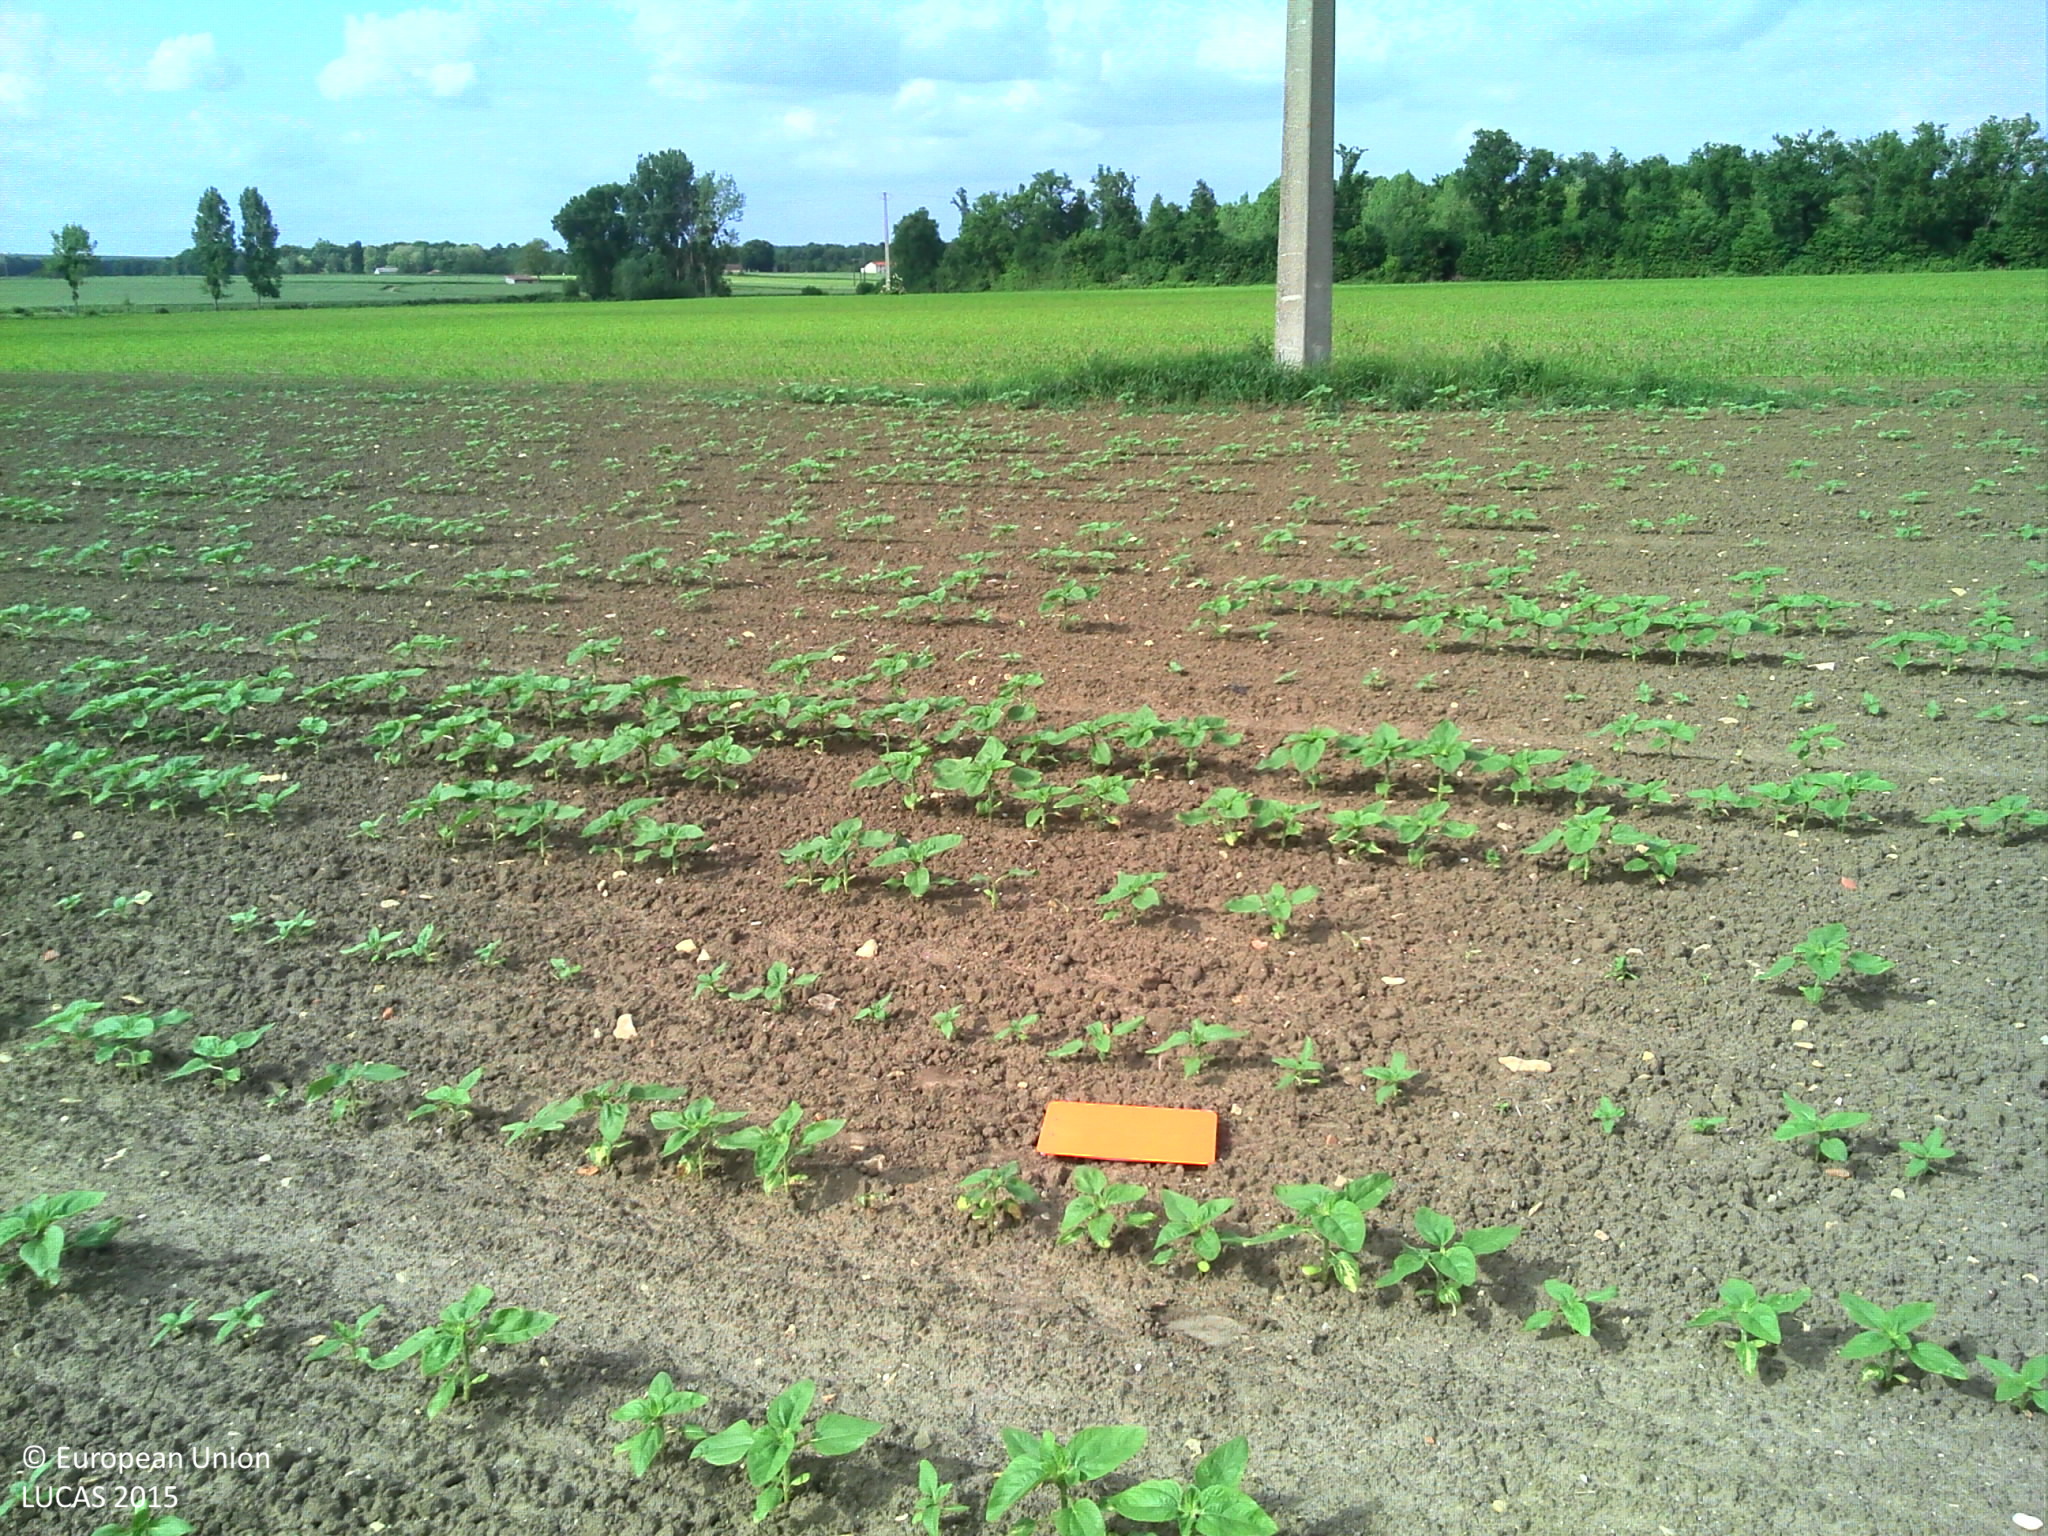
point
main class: Cropland
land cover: Sunflower
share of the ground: 10 - 25 %
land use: Agriculture (excluding fallow land and kitchen gardens)
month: May
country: FR
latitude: 46.8286
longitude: 0.2387
